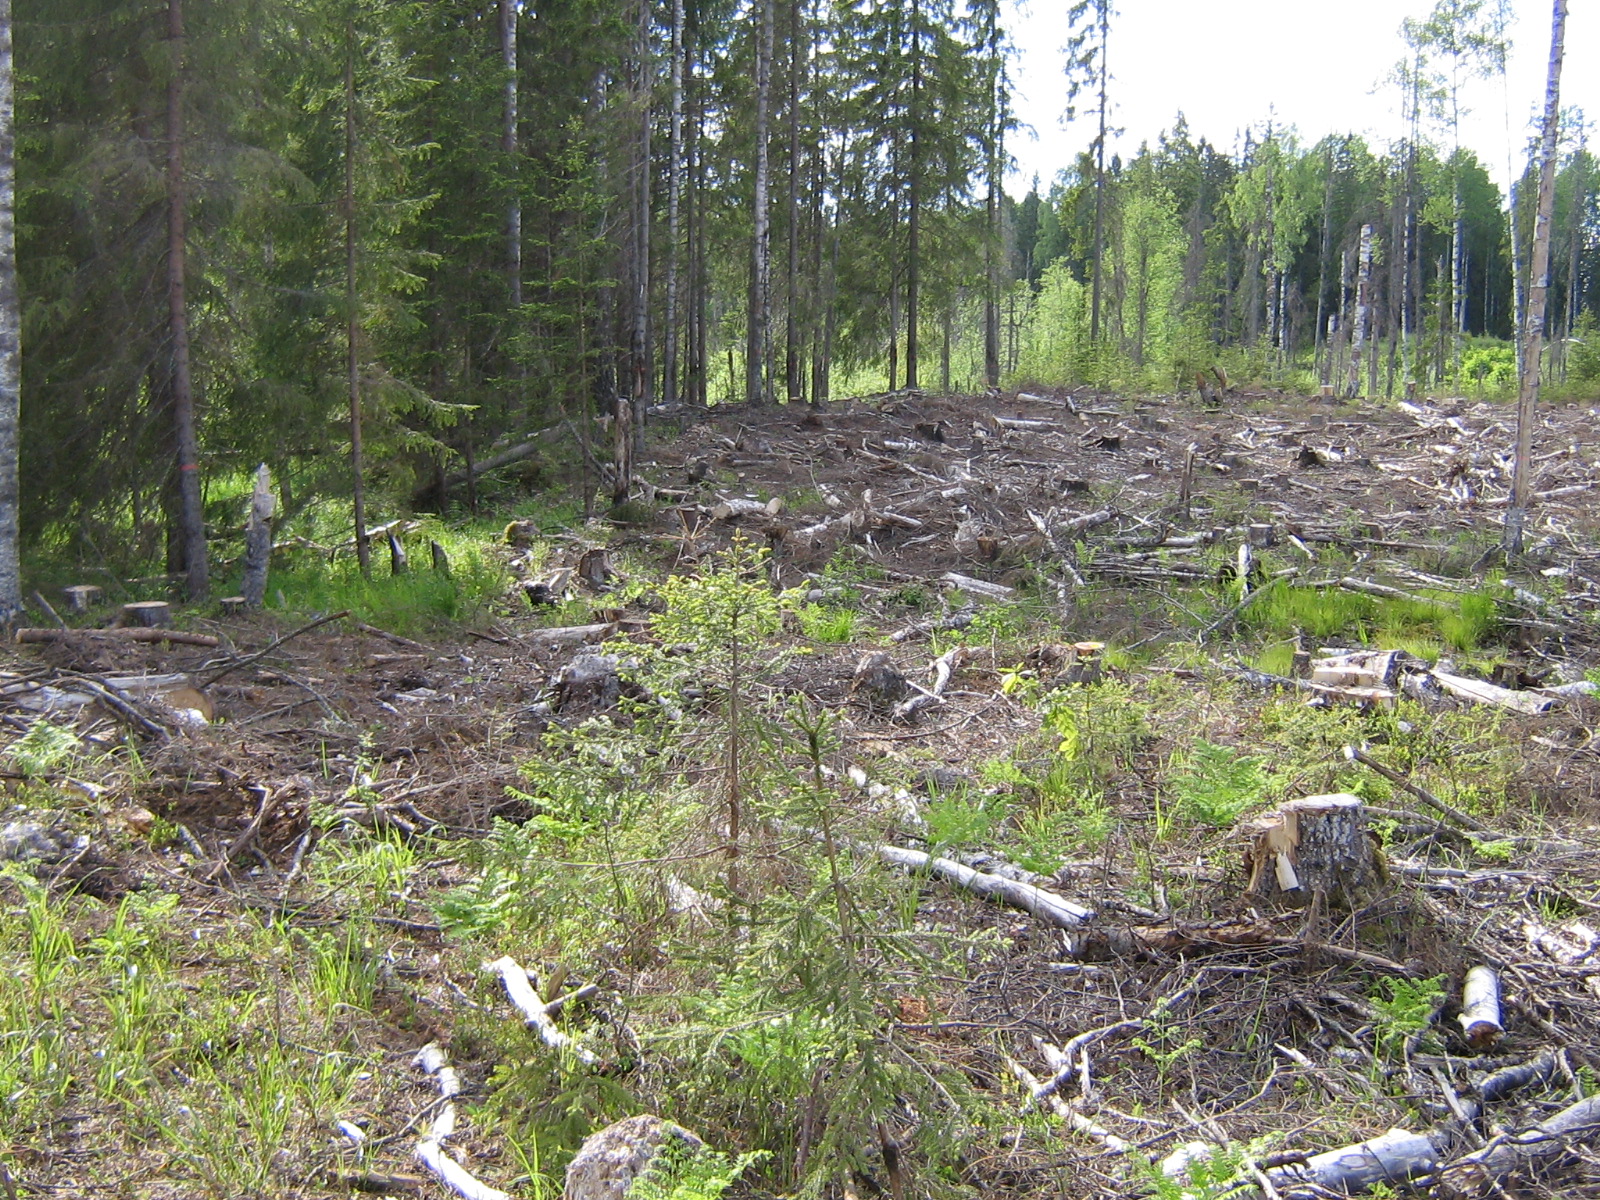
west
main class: Grassland
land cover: Spontaneously vegetated surfaces
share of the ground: 25 - 50 %
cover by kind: unconsolidated bare surface 55 %, herbaceous plants 35 %, lichens and mosses 10 %
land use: Forestry
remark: Clear cut
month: June
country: LV
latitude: 57.1887
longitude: 25.7601
